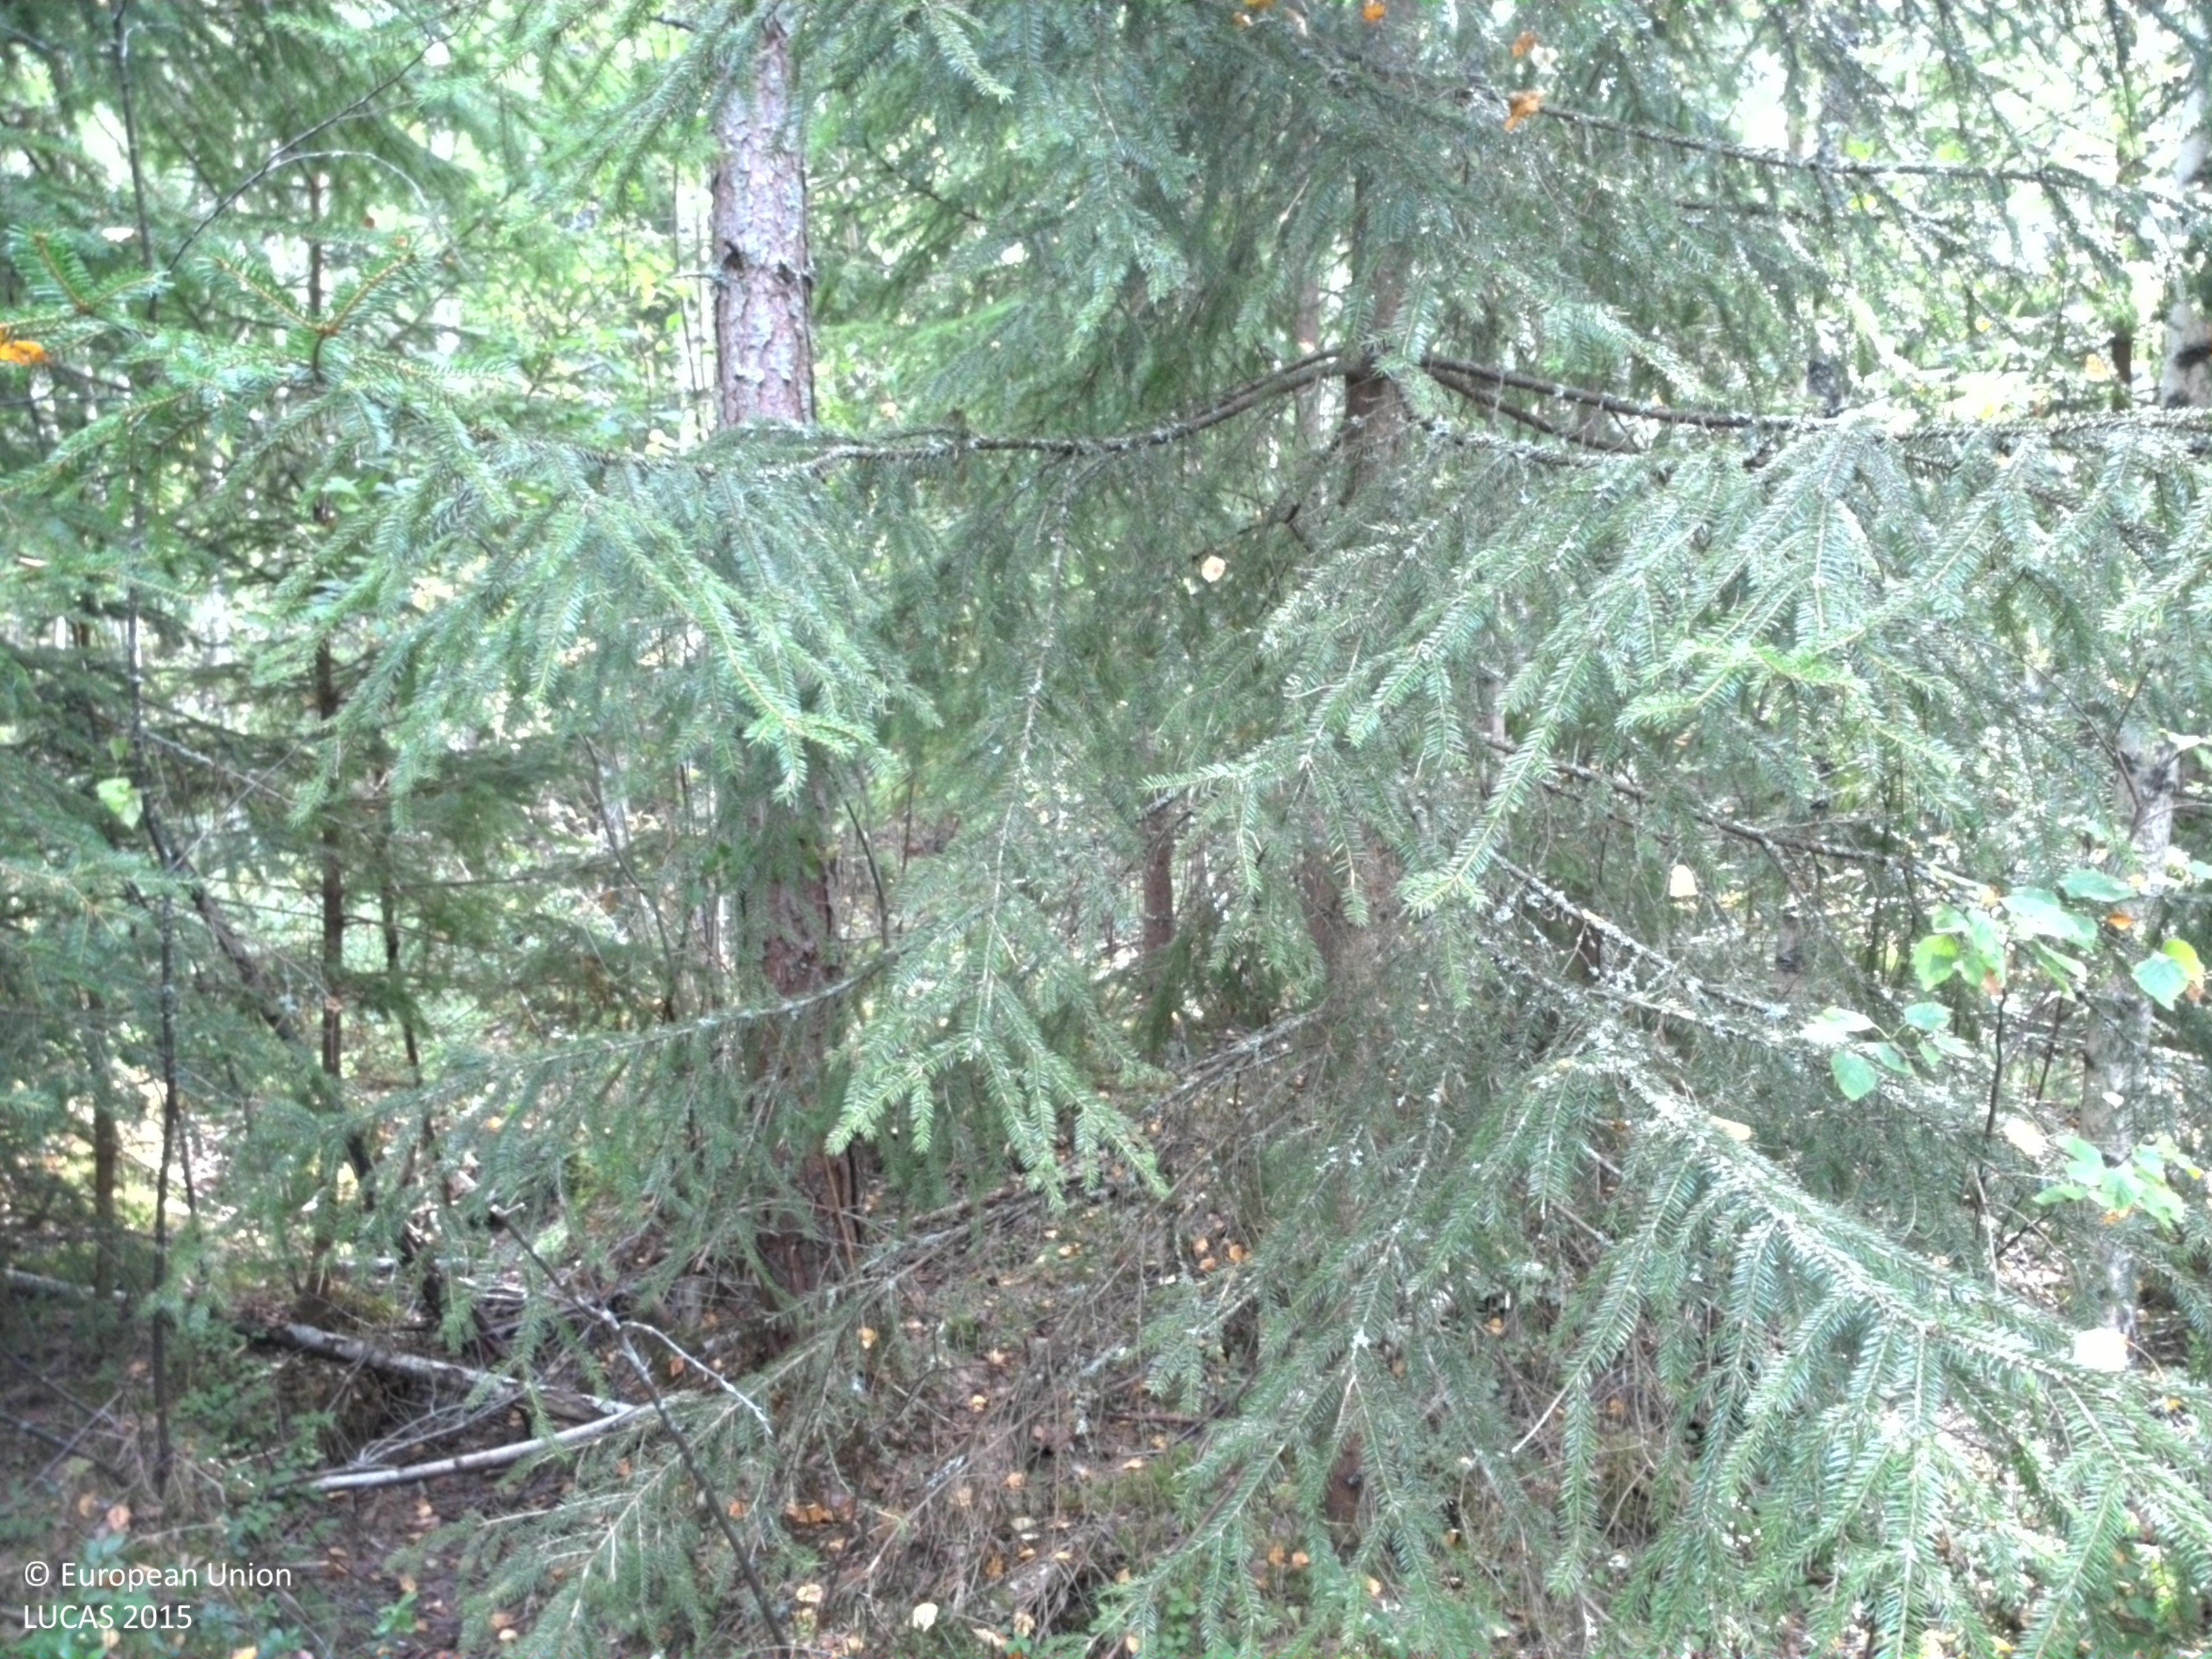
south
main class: Woodland
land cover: Pine dominated mixed woodland
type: boreal forest
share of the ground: 50 - 75 %
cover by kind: coniferous forest trees 55 %, broadleaved forest trees 20 %, lichens and mosses 20 %, shrubs 5 %
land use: Forestry
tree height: > 5 m
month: August
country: SE
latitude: 59.6160
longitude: 13.4481
